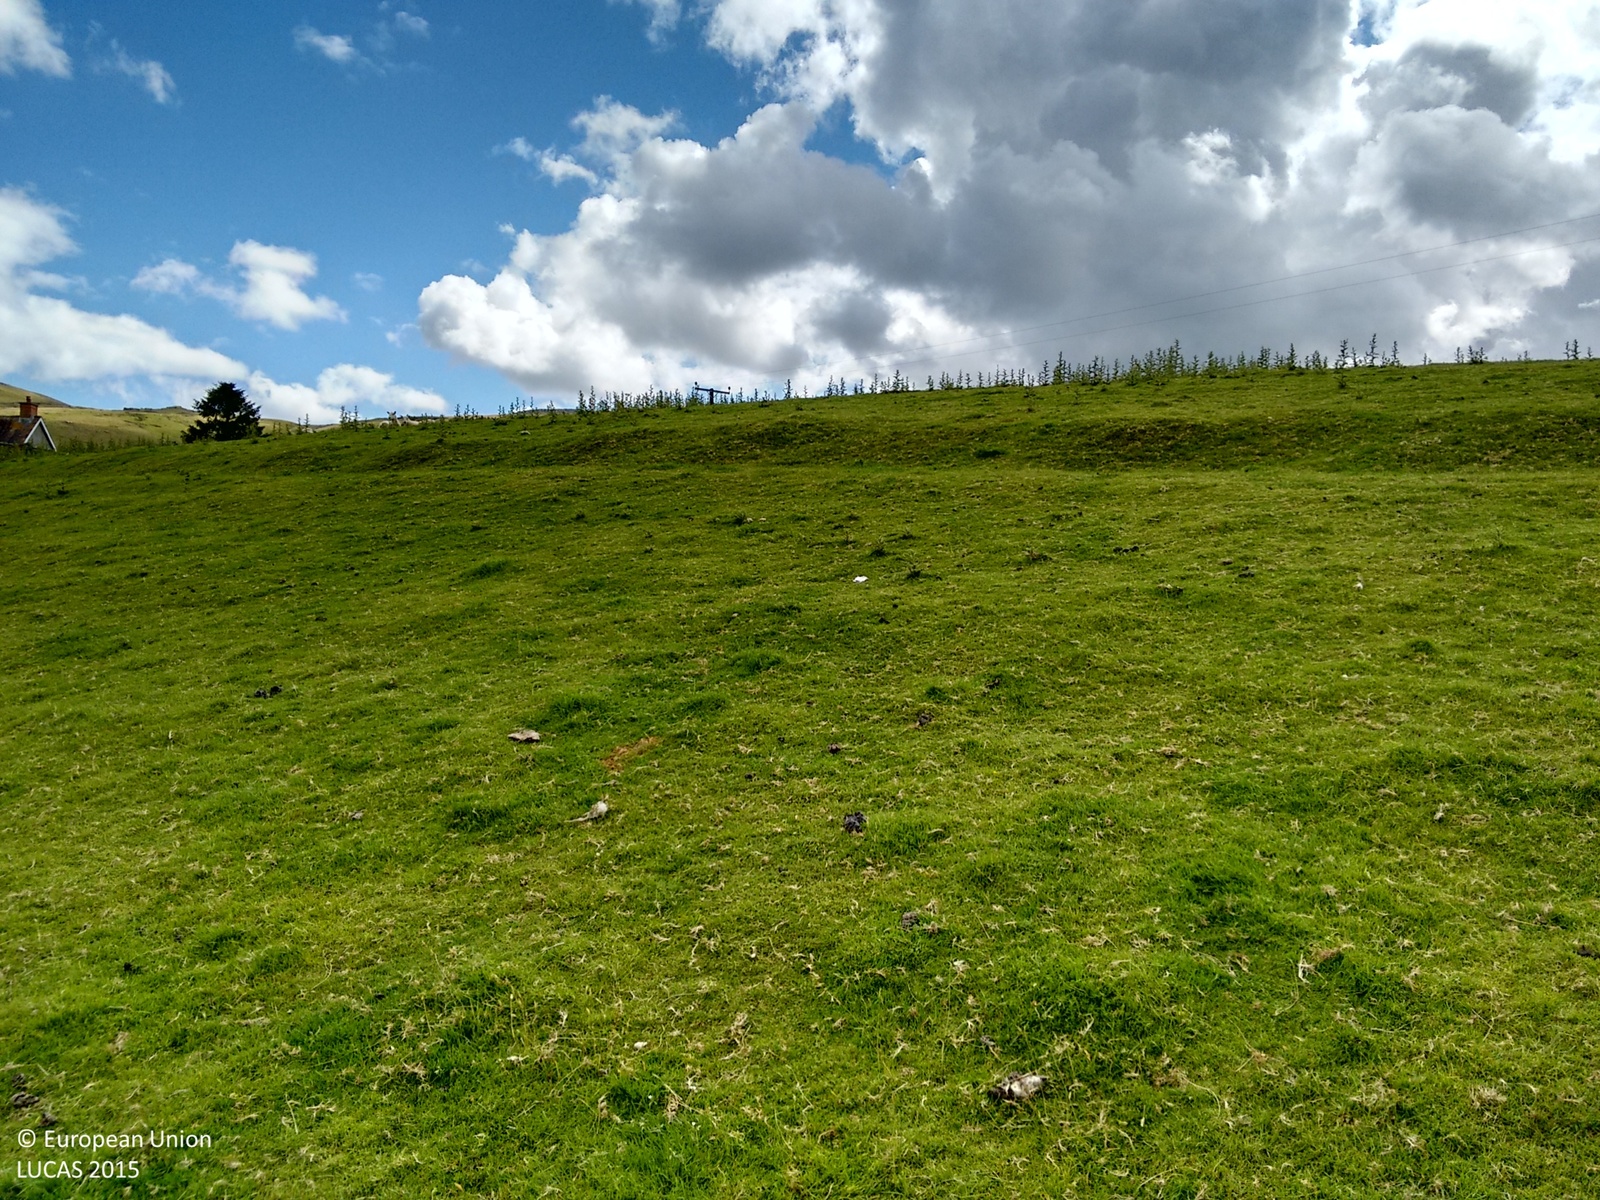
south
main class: Grassland
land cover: Grassland without tree/shrub cover
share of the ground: > 75 %
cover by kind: herbaceous plants 100 %
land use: Agriculture (excluding fallow land and kitchen gardens)
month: July
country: GB
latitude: 51.8712
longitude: -3.8457
